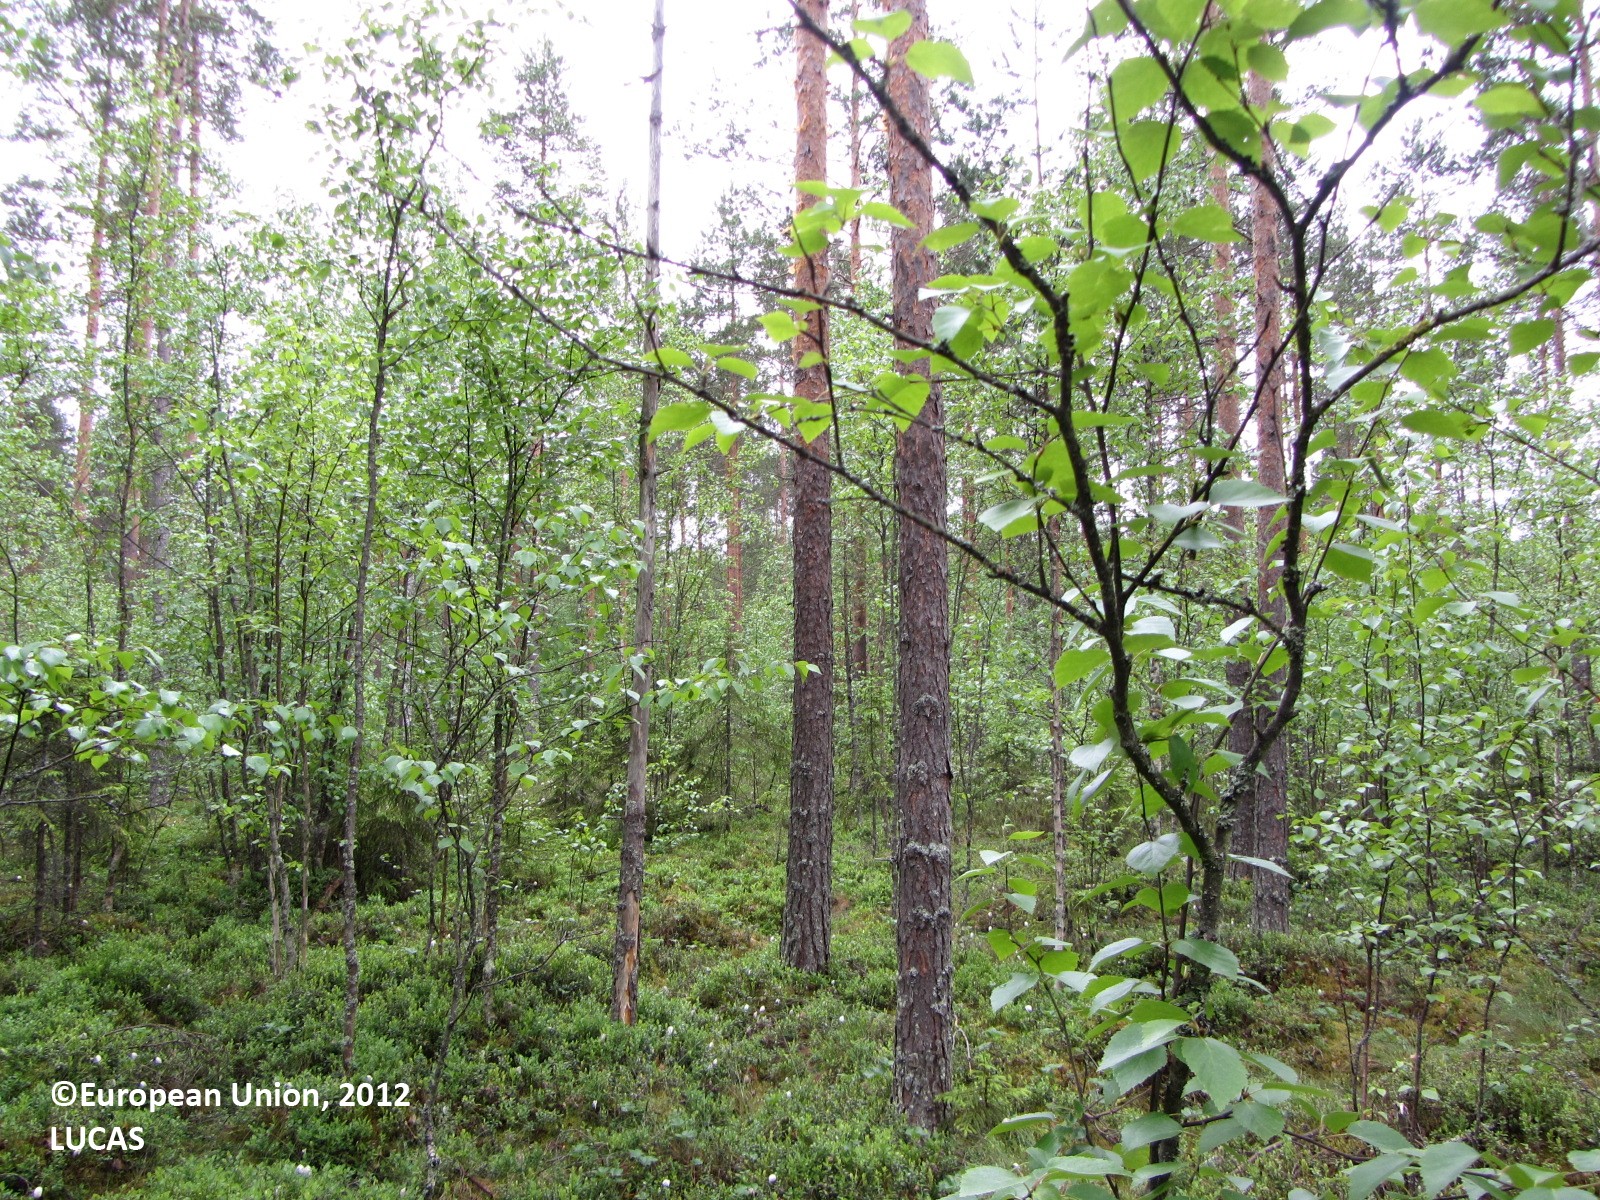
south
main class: Woodland
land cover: Pine dominated mixed woodland
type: boreal forest
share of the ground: 50 - 75 %
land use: Forestry
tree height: > 5 m
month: June
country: FI
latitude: 61.9634
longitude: 25.1948
